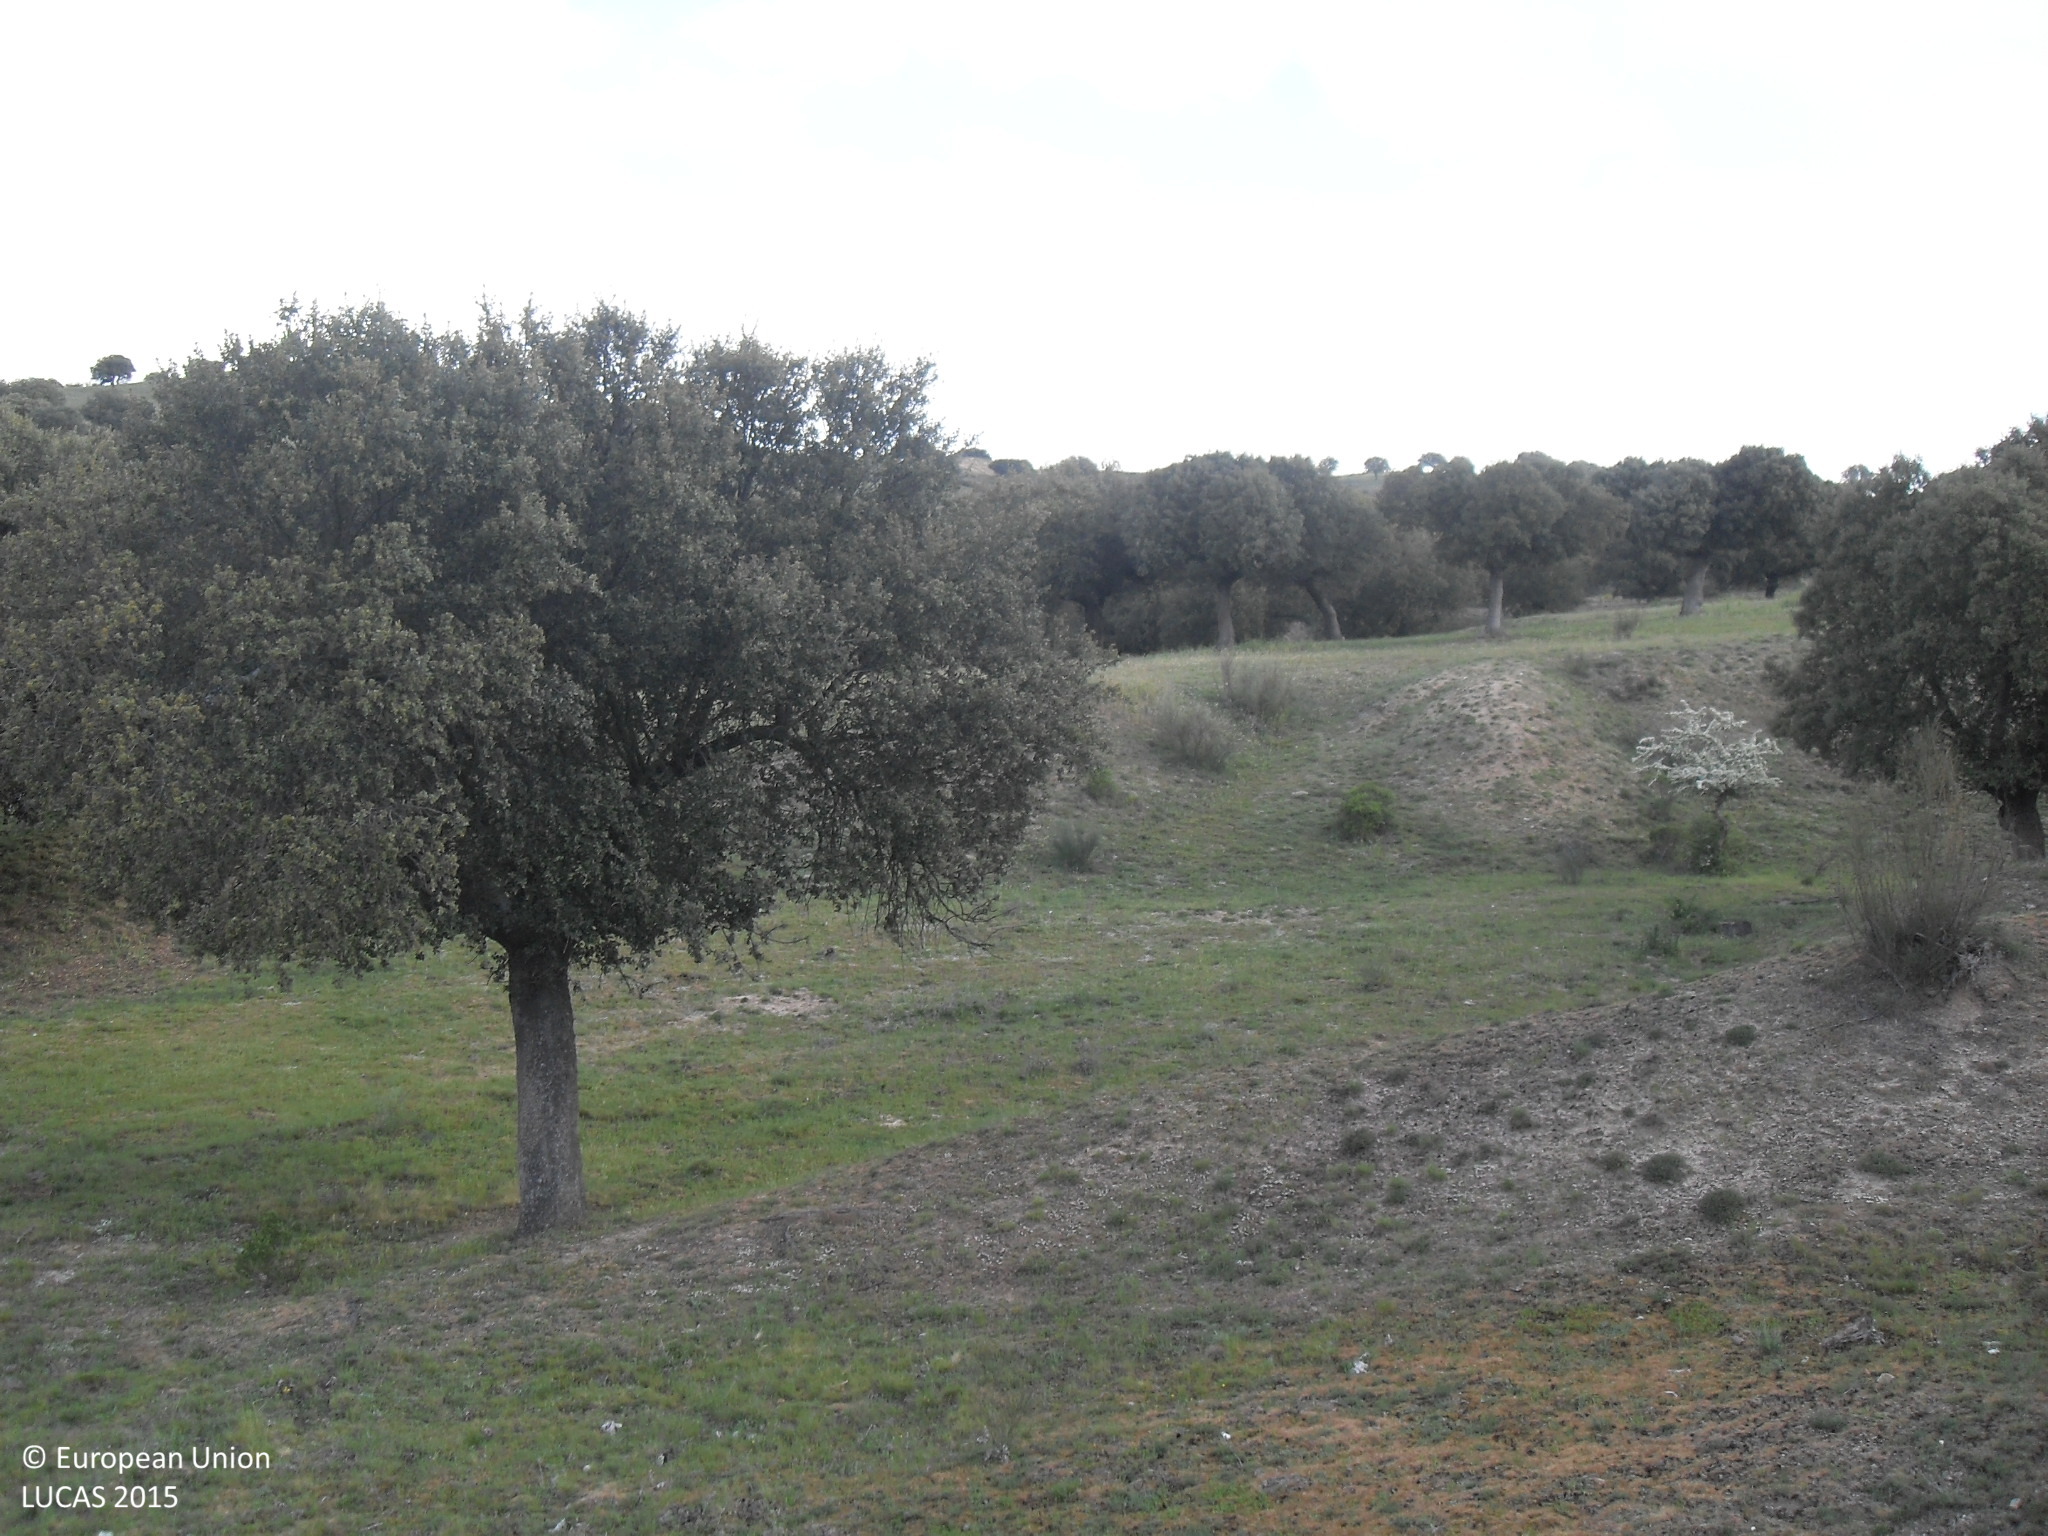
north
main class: Woodland
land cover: Broadleaved woodland
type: broadleaved evergreen forest
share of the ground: 10 - 25 %
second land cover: Grassland without tree/shrub cover
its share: > 75 %
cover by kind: herbaceous plants 85 %, broadleaved forest trees 15 %
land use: Forestry
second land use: Agriculture (excluding fallow land and kitchen gardens)
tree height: > 5 m
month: May
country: ES
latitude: 40.8475
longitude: -5.1413
